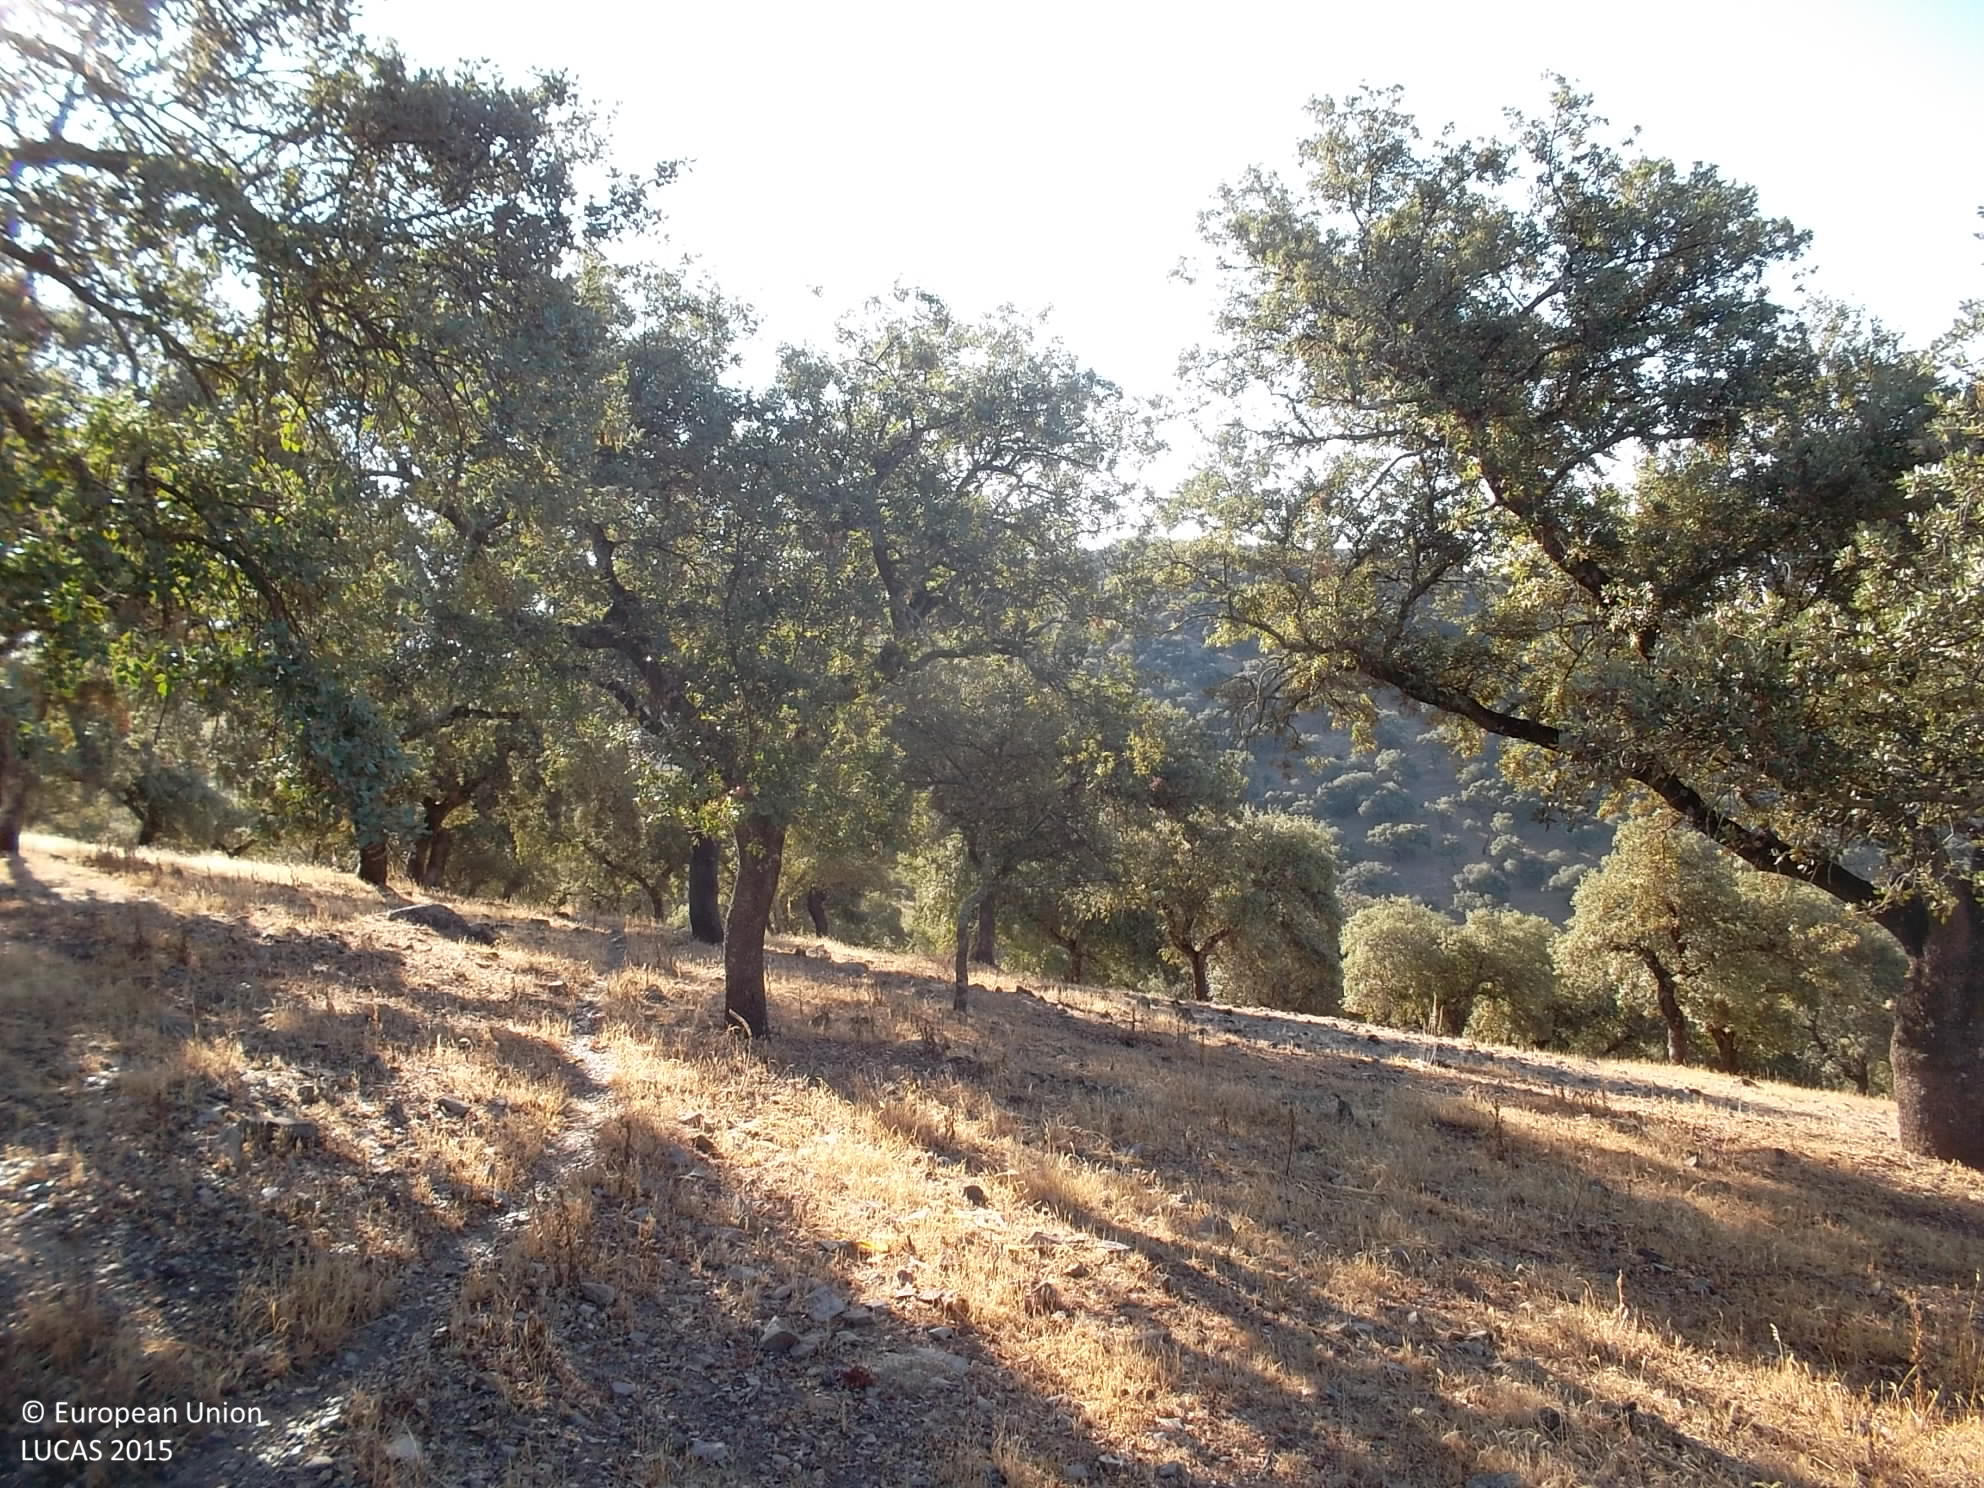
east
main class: Woodland
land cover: Broadleaved woodland
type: broadleaved evergreen forest
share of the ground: 50 - 75 %
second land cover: Grassland without tree/shrub cover
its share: > 75 %
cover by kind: broadleaved forest trees 50 %, herbaceous plants 50 %
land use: Forestry
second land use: Agriculture (excluding fallow land and kitchen gardens)
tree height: < 5 m
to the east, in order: Broadleaved woodland; Grassland without tree/shrub cover; Dry stone walls; Broadleaved woodland; Dry stone walls
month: August
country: ES
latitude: 38.4919
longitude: -6.5992
